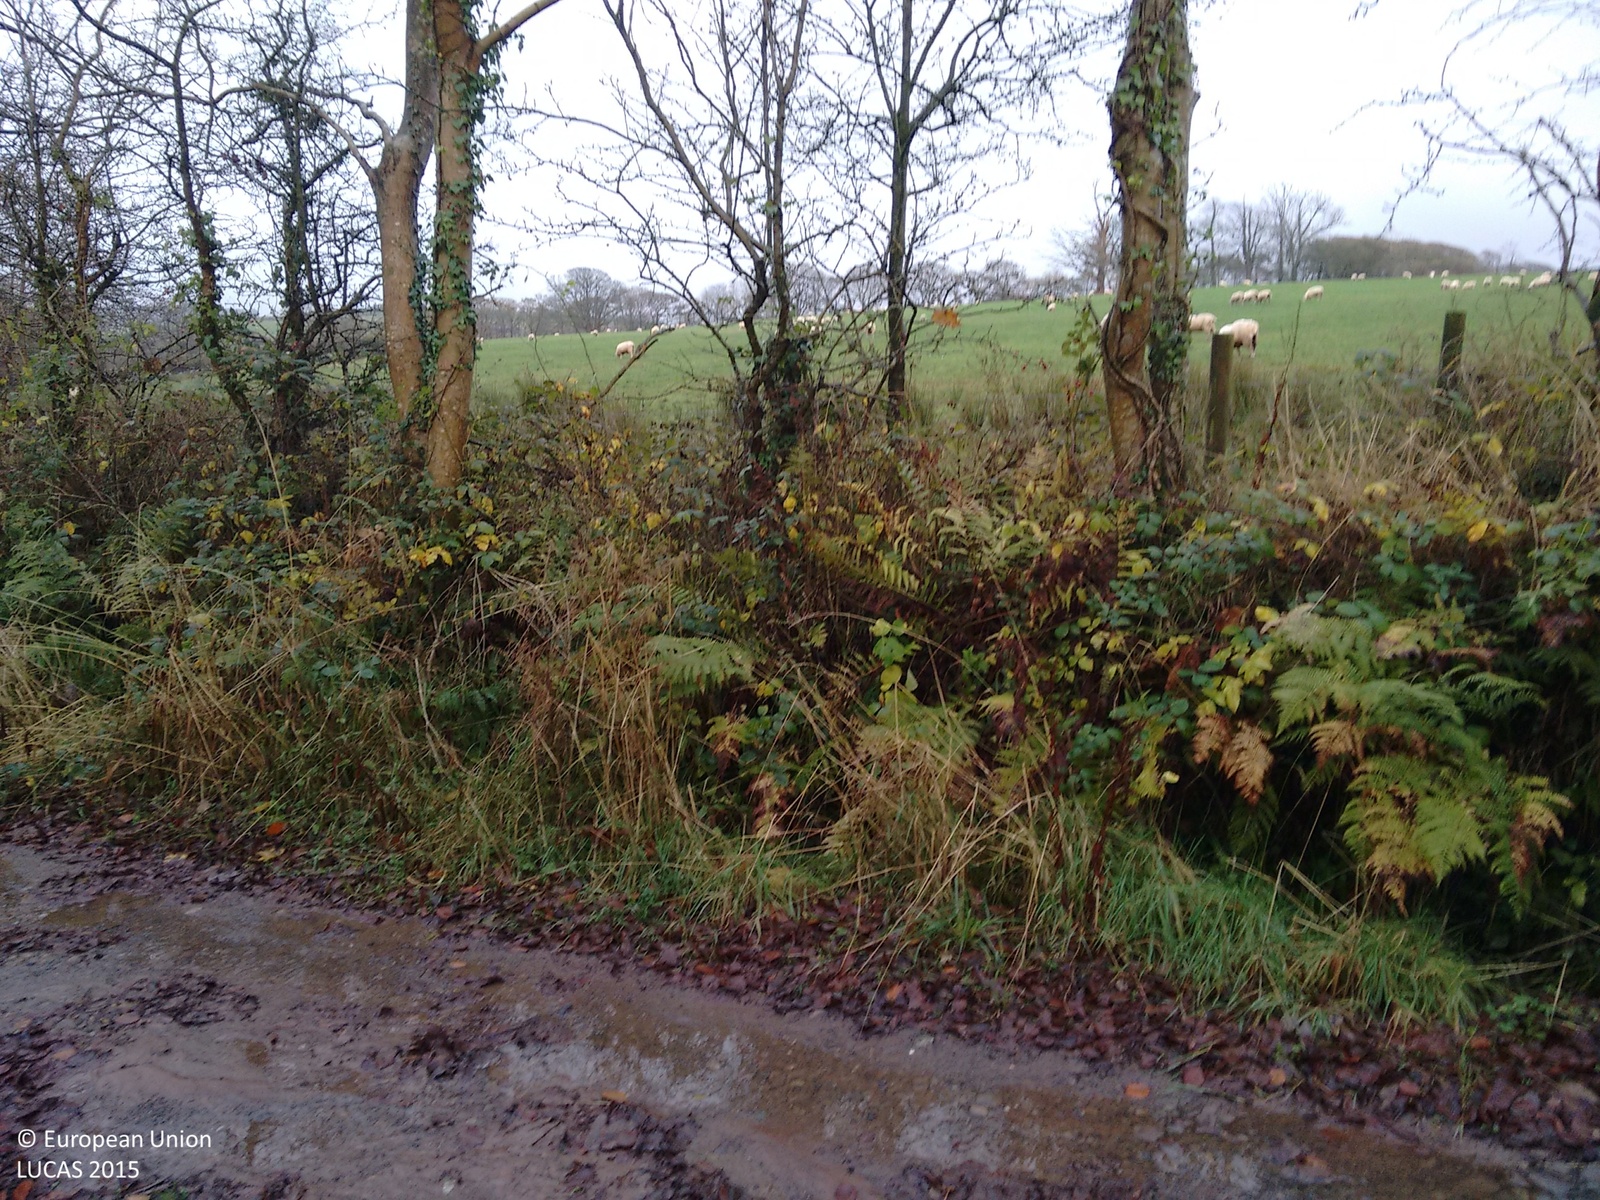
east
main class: Woodland
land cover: Broadleaved woodland
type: mesophytic deciduous forest
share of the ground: > 75 %
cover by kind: broadleaved forest trees 90 %, shrubs 10 %
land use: Forestry
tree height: > 5 m
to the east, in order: Broadleaved woodland; Grass margins; Tracks; Grass margins; Managed hedges; Fences; Grassland without tree/shrub cover; Managed hedges; Fences; Grass margins; Paved roads, cycling and walking lanes
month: November
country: GB
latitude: 54.4671
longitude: -3.4896
